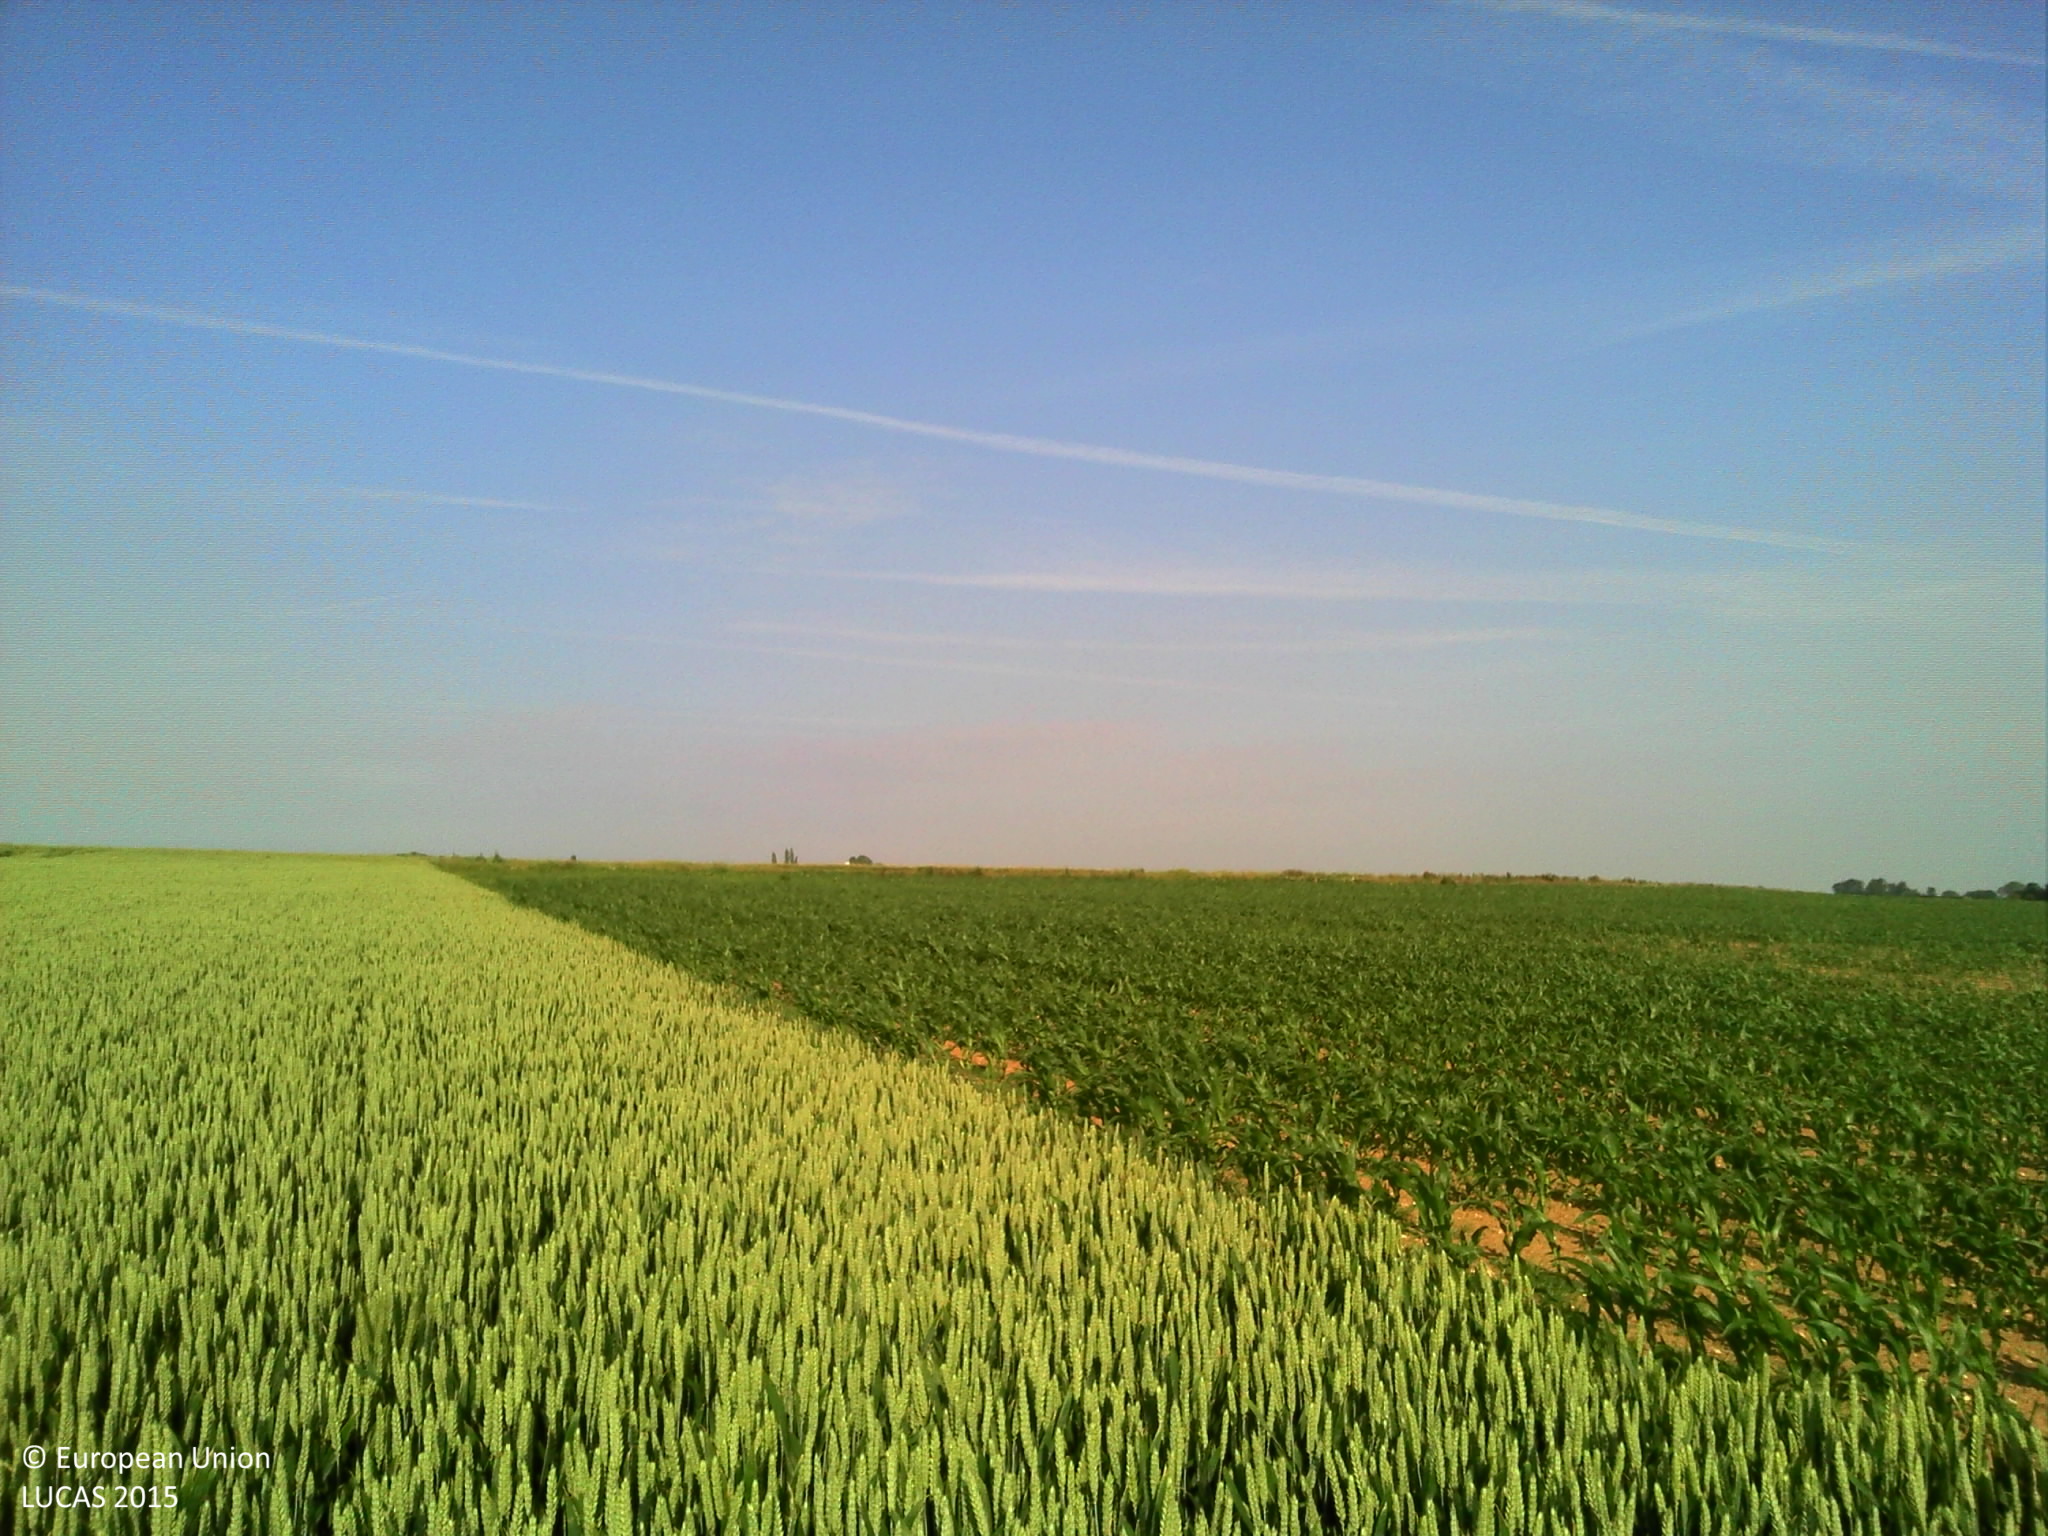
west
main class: Cropland
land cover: Common wheat
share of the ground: > 75 %
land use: Agriculture (excluding fallow land and kitchen gardens)
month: June
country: FR
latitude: 49.4350
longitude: 2.5557
